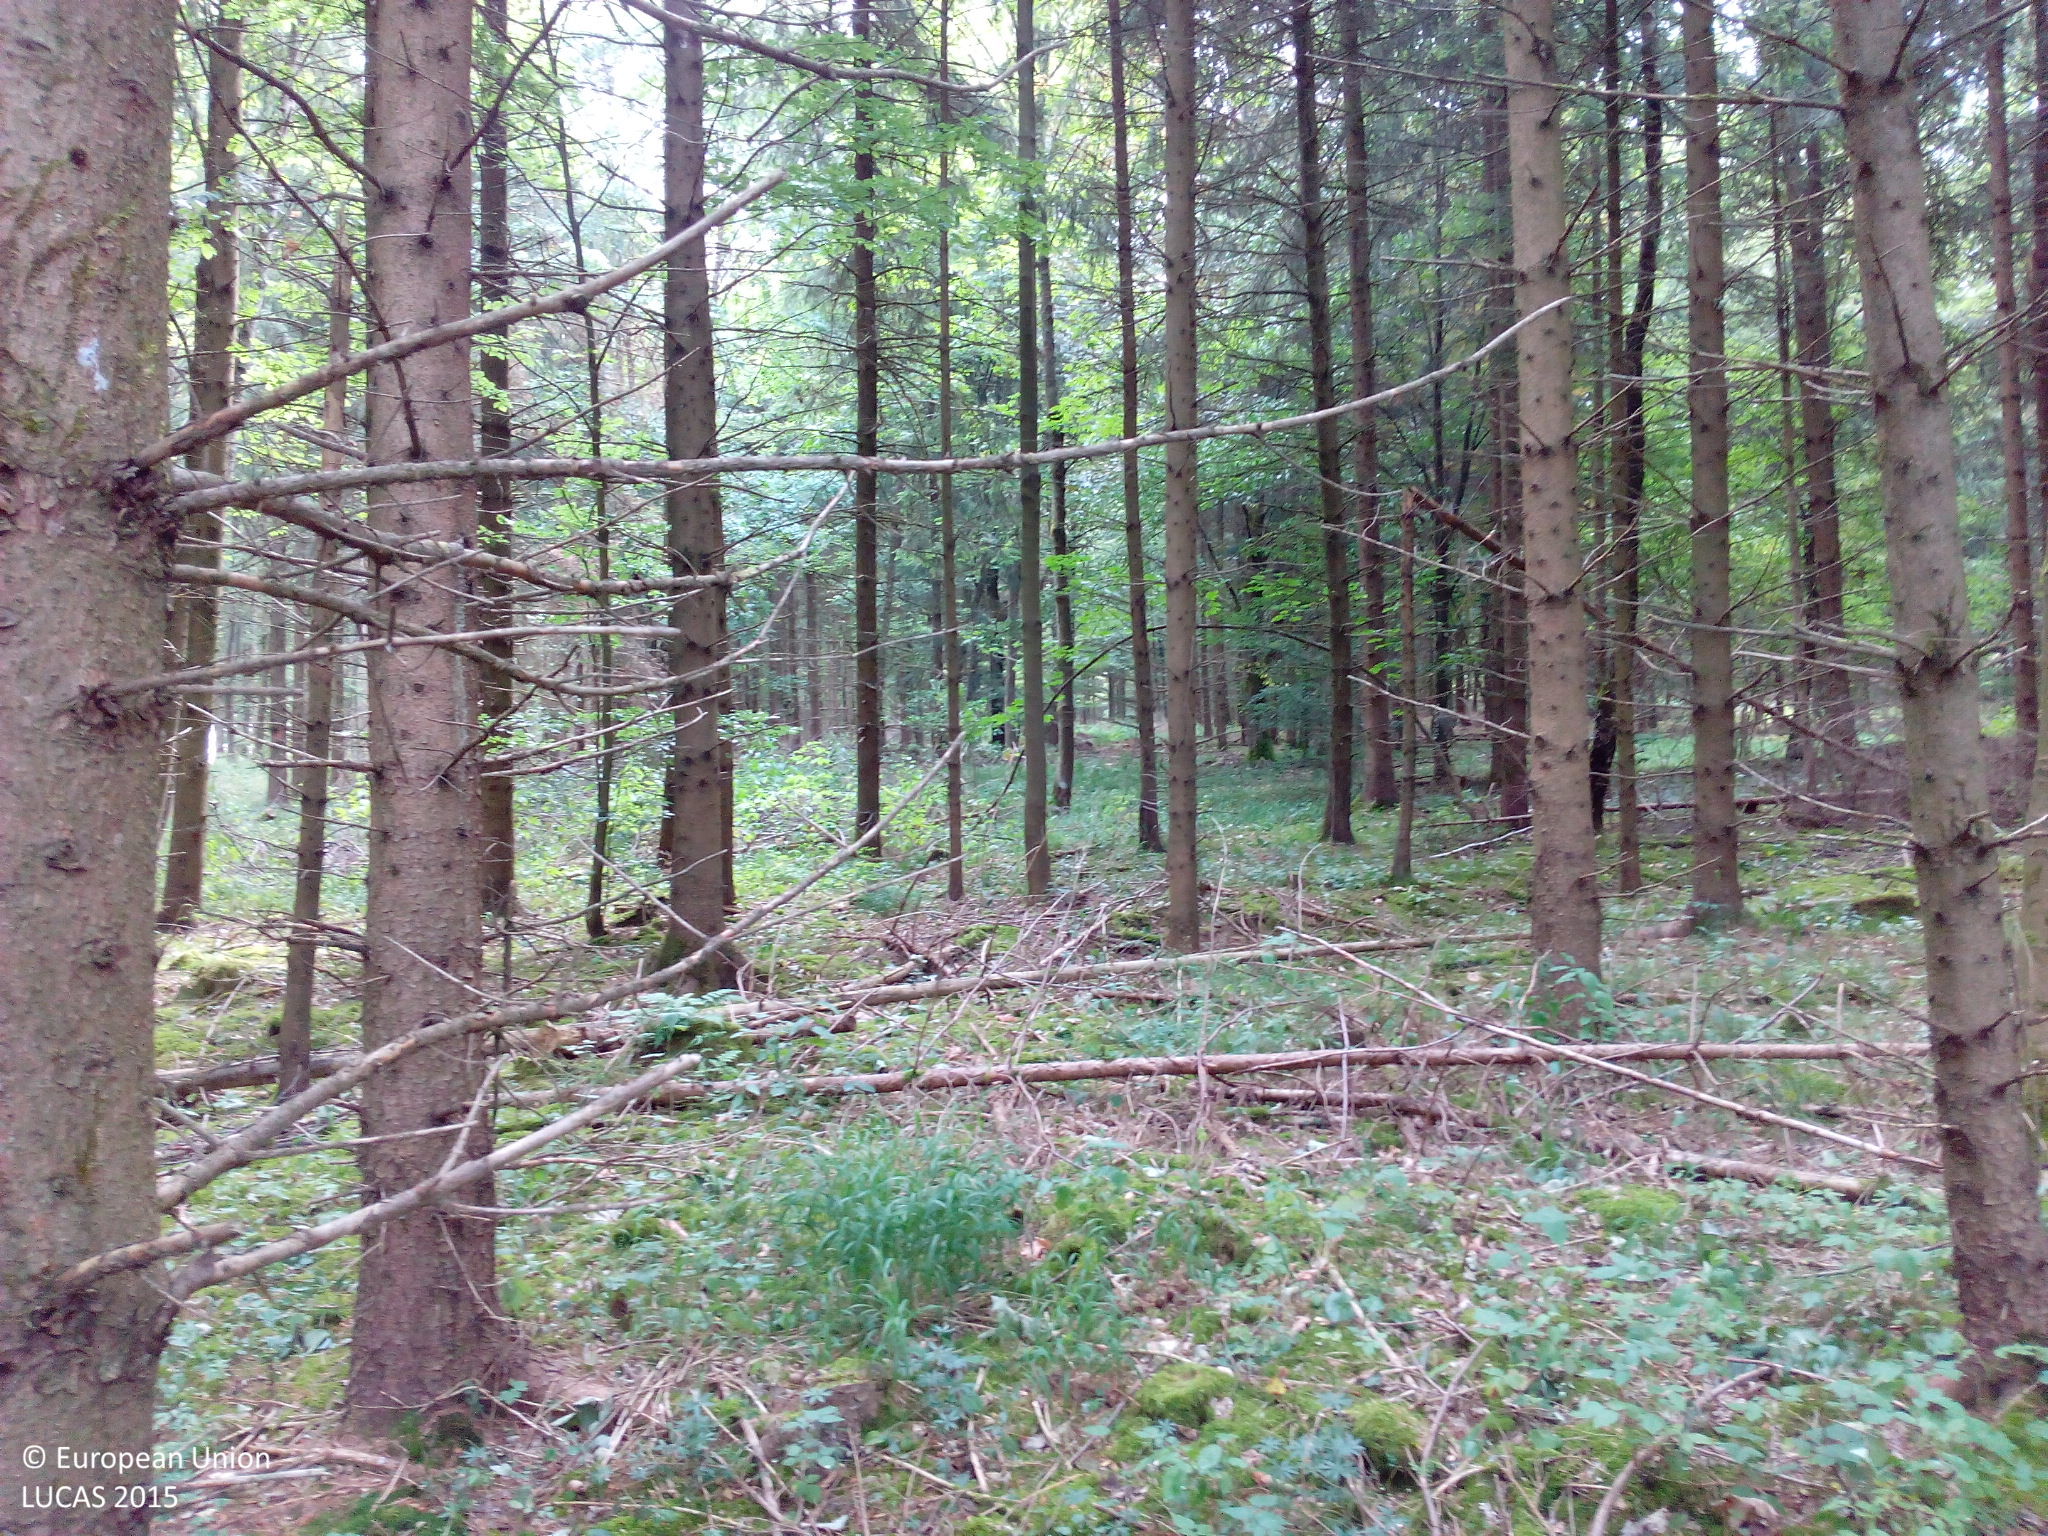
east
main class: Woodland
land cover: Spruce dominated mixed woodland
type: hemiboreal forest and nemoral coniferous forest and mixed broadleaved-coniferous forest
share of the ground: > 75 %
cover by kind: coniferous forest trees 45 %, broadleaved forest trees 30 %, lichens and mosses 15 %, shrubs 5 %, herbaceous plants 5 %
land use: Forestry
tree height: > 5 m
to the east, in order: Spruce dominated mixed woodland; Tracks; Spruce dominated mixed woodland; Tracks; Spruce dominated mixed woodland; Spruce dominated coniferous woodland; Tracks; Spruce dominated coniferous woodland
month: July
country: DE
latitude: 48.8169
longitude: 10.3131
